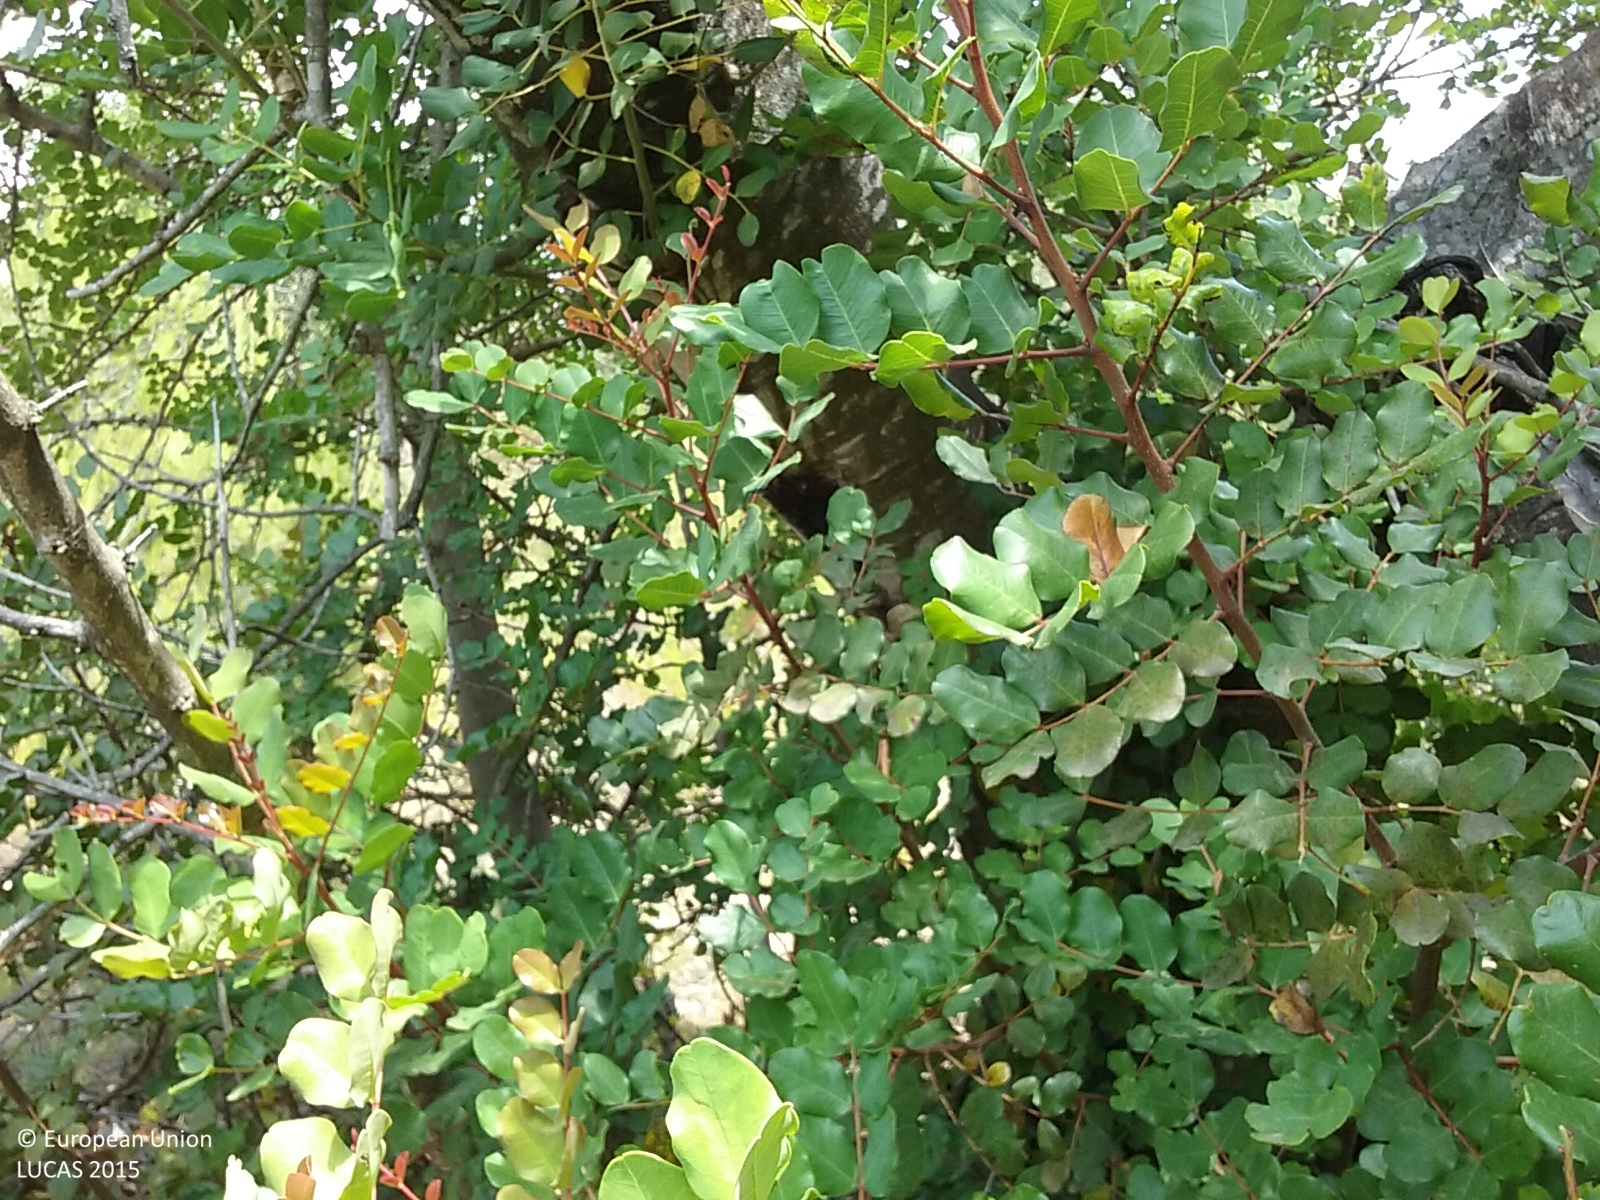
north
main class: Cropland
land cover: Permanent industrial crops
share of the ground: 10 - 25 %
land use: Abandoned areas
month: July
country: ES
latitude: 40.2570
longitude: -0.0799
